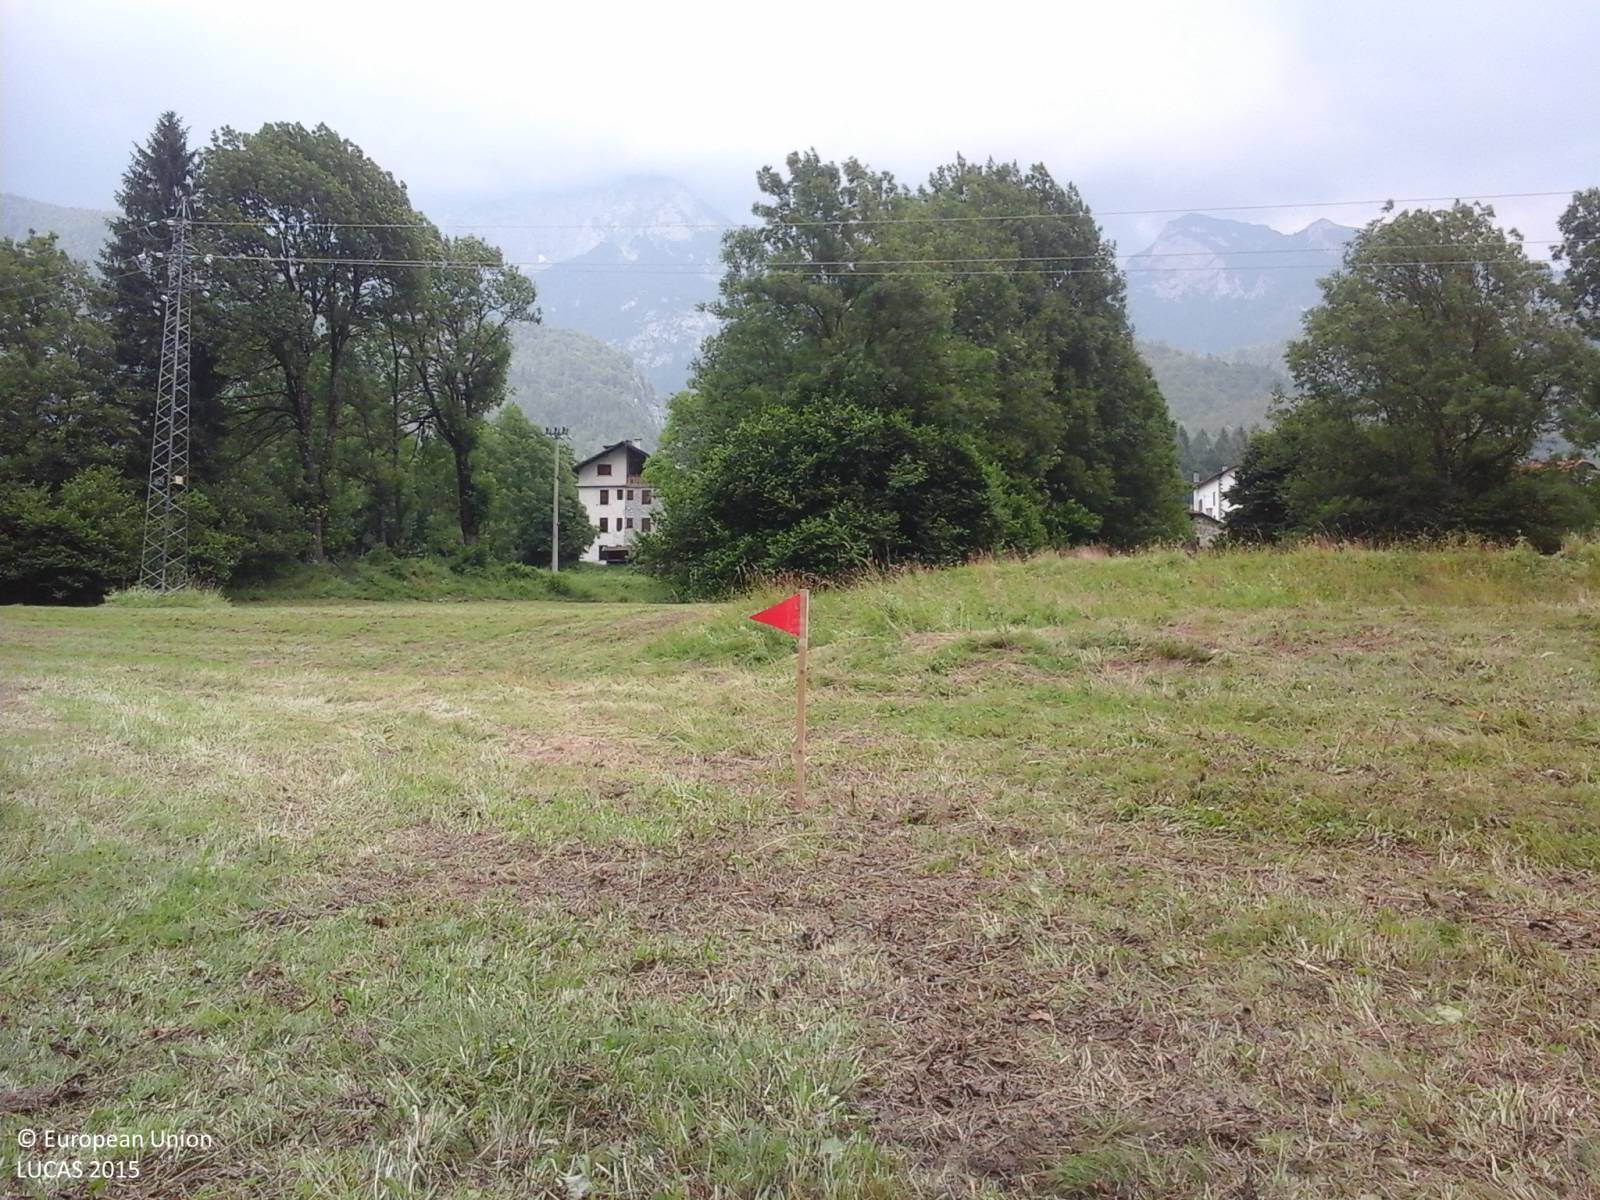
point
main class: Grassland
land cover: Grassland without tree/shrub cover
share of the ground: > 75 %
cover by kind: herbaceous plants 100 %
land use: Agriculture (excluding fallow land and kitchen gardens)
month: July
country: IT
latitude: 46.4101
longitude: 12.5859
